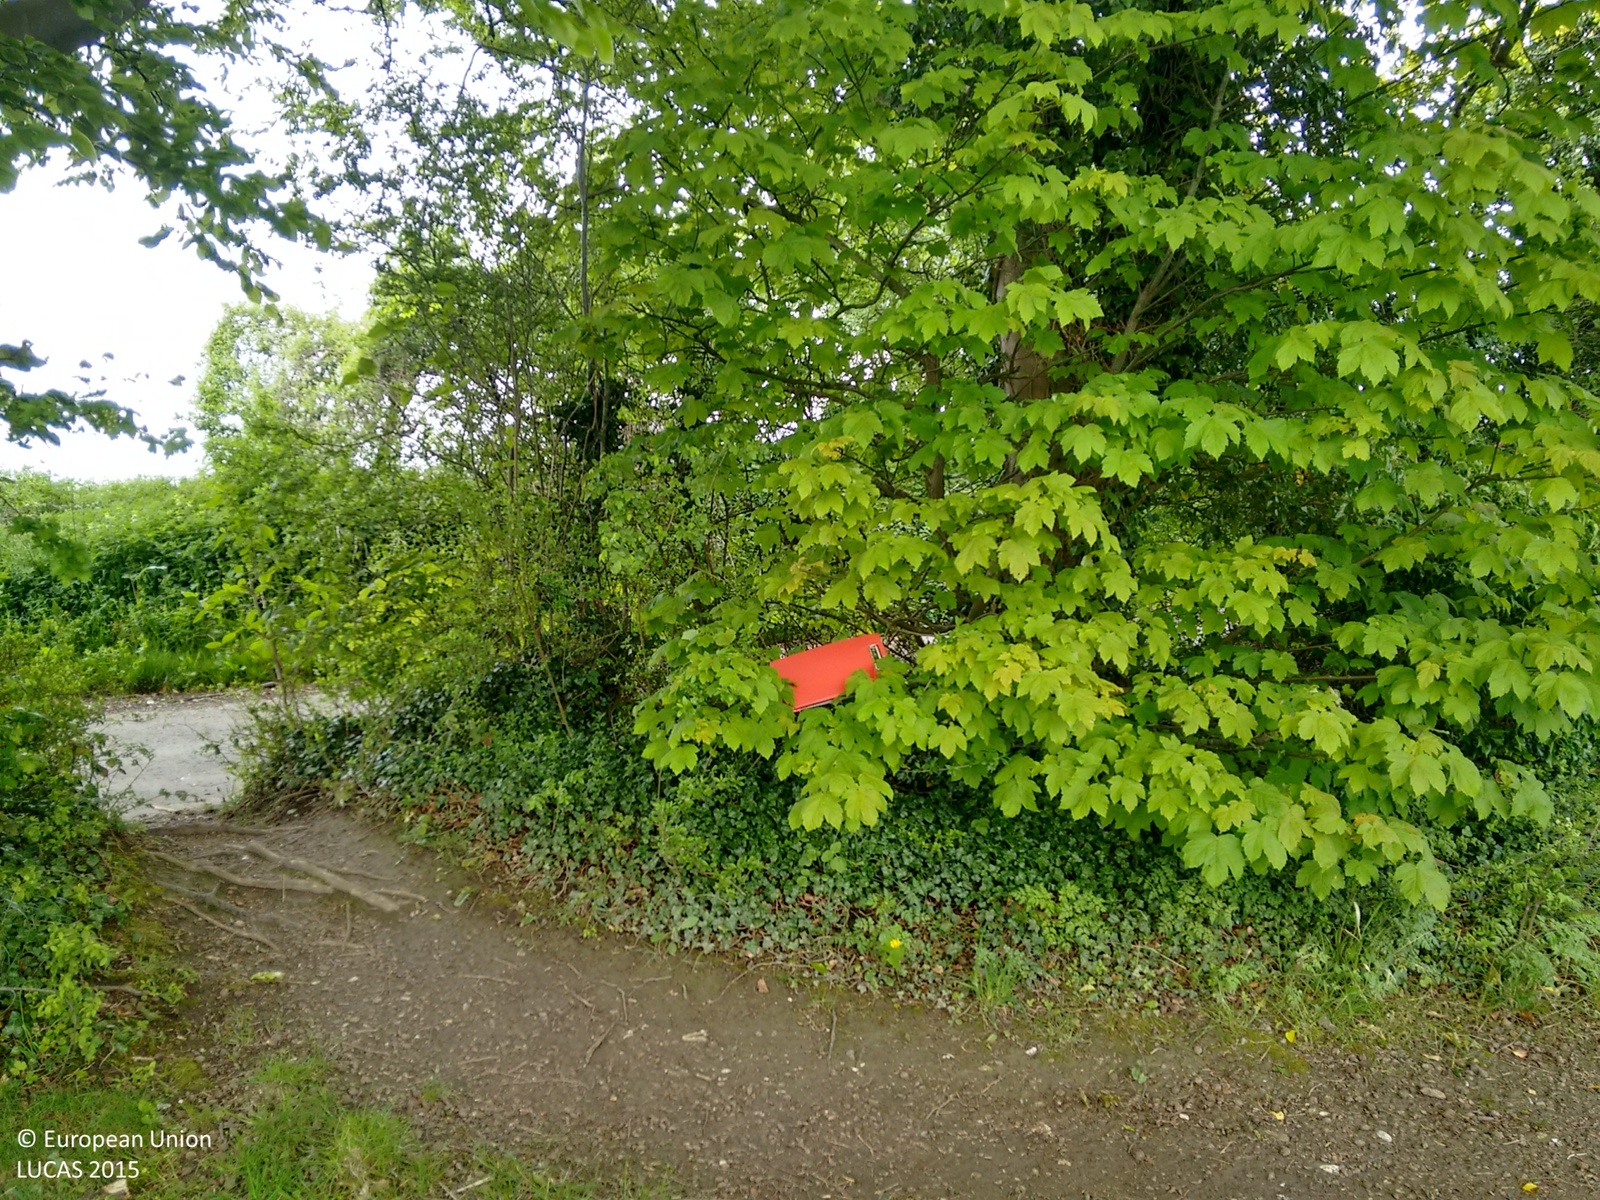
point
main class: Woodland
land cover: Broadleaved woodland
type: mesophytic deciduous forest
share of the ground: > 75 %
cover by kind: broadleaved forest trees 100 %
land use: Forestry
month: May
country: GB
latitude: 51.2030
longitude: -1.4575
